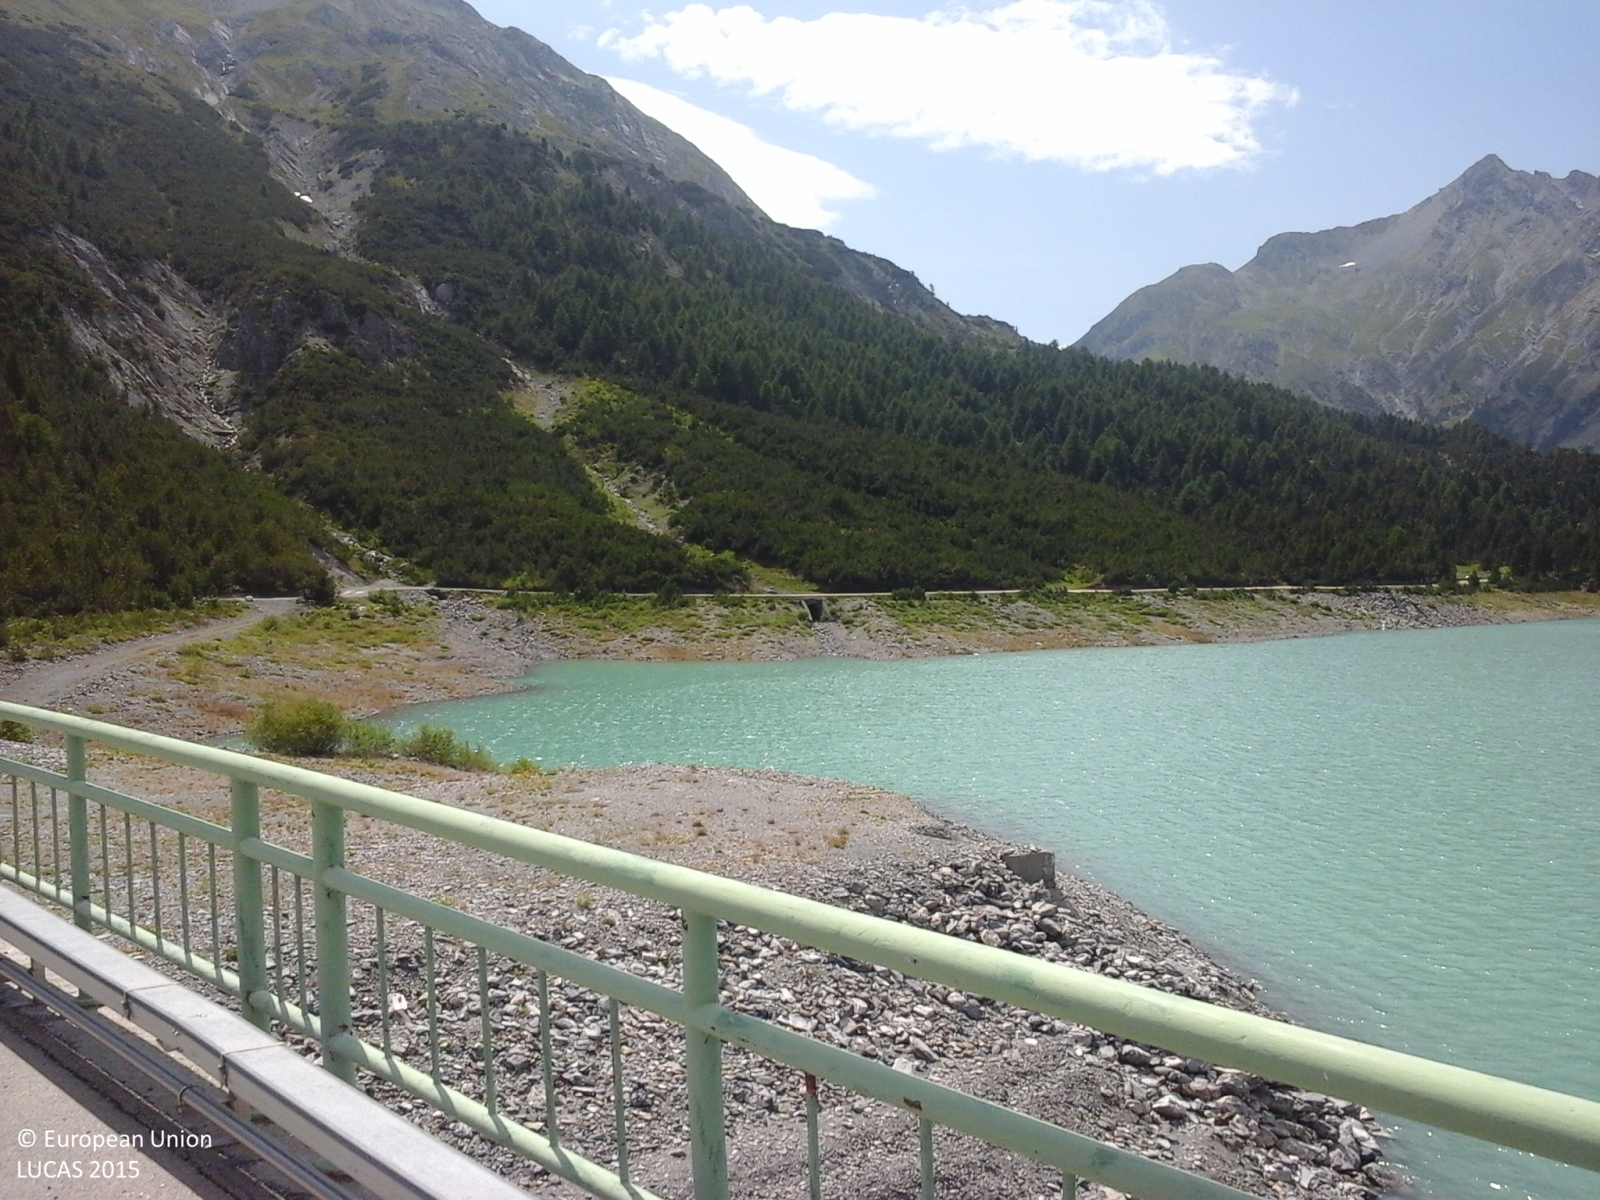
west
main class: Woodland
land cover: Spruce dominated coniferous woodland
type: alpine coniferous forest
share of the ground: > 75 %
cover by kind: coniferous forest trees 100 %
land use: Semi-natural and natural areas not in use
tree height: > 5 m
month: July
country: IT
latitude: 46.5310
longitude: 10.2734
